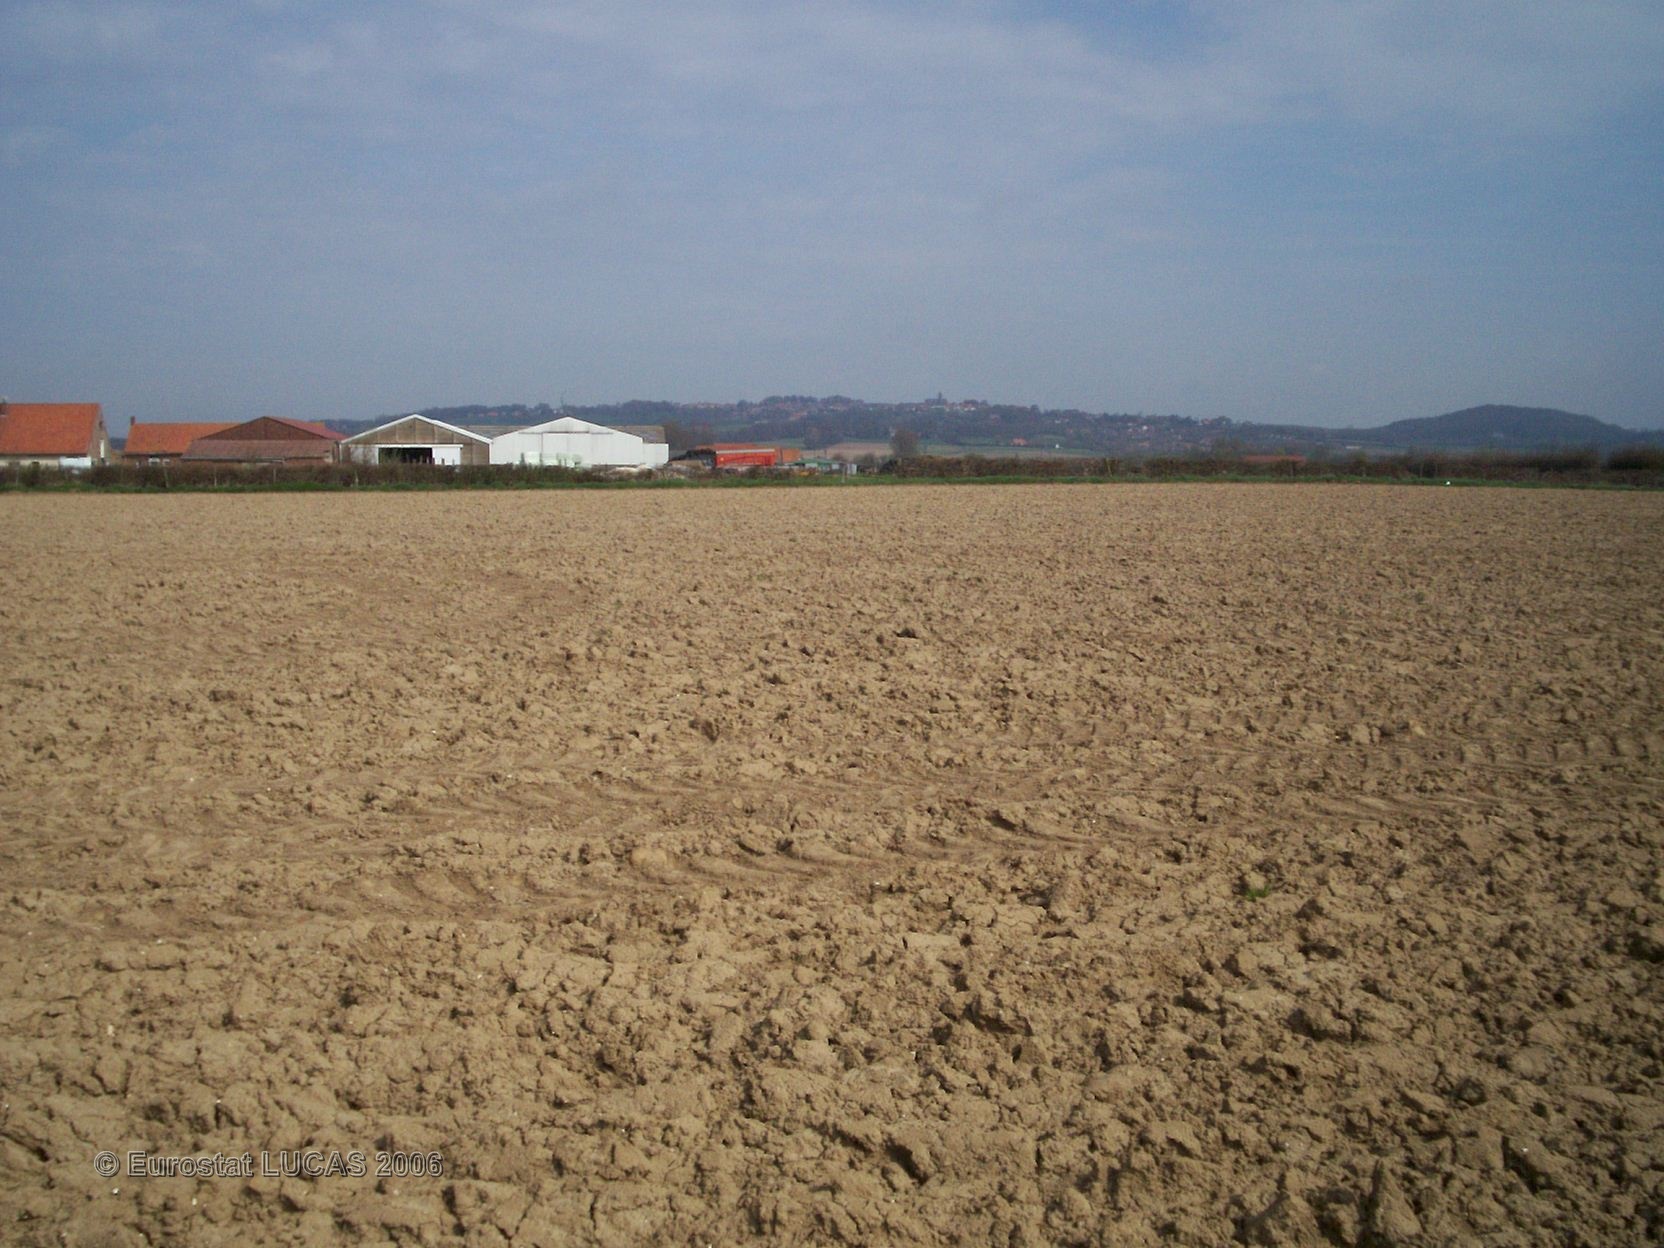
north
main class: Cropland
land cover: Potatoes
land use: Agriculture (excluding fallow land and kitchen gardens)
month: May
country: FR
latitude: 50.7669
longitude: 2.4867
